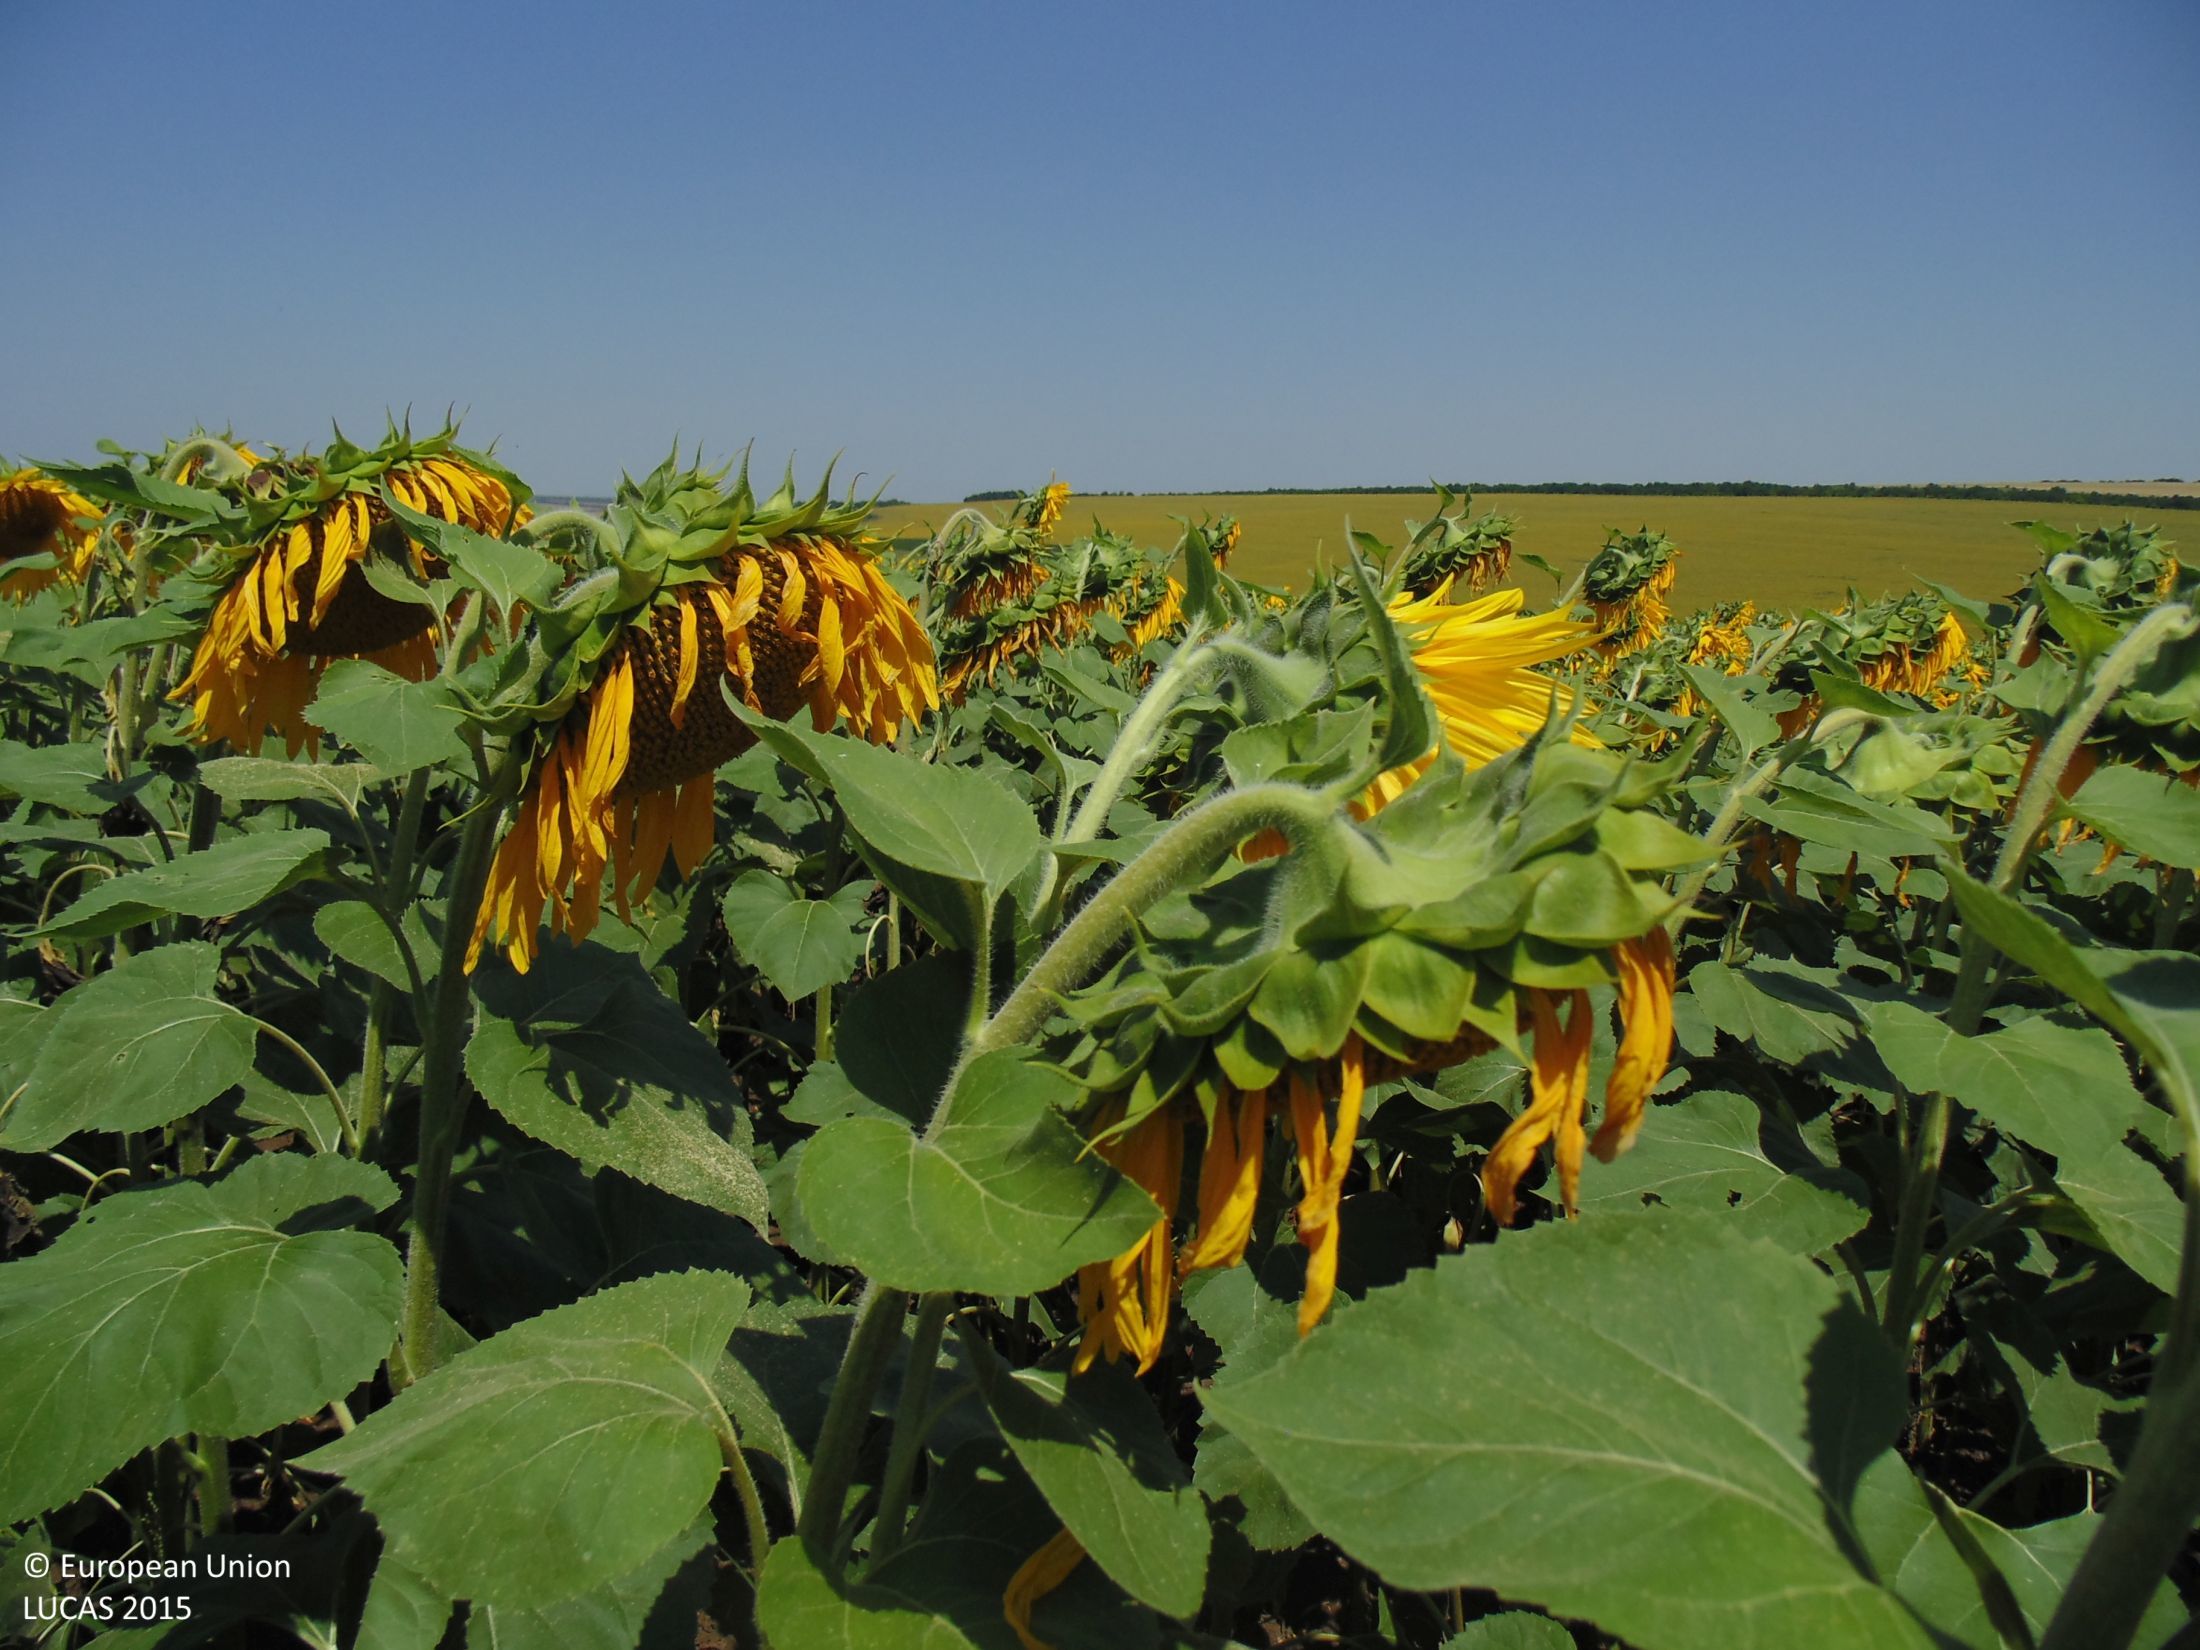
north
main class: Cropland
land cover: Sunflower
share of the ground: > 75 %
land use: Agriculture (excluding fallow land and kitchen gardens)
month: July
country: BG
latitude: 43.5679
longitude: 27.6050
